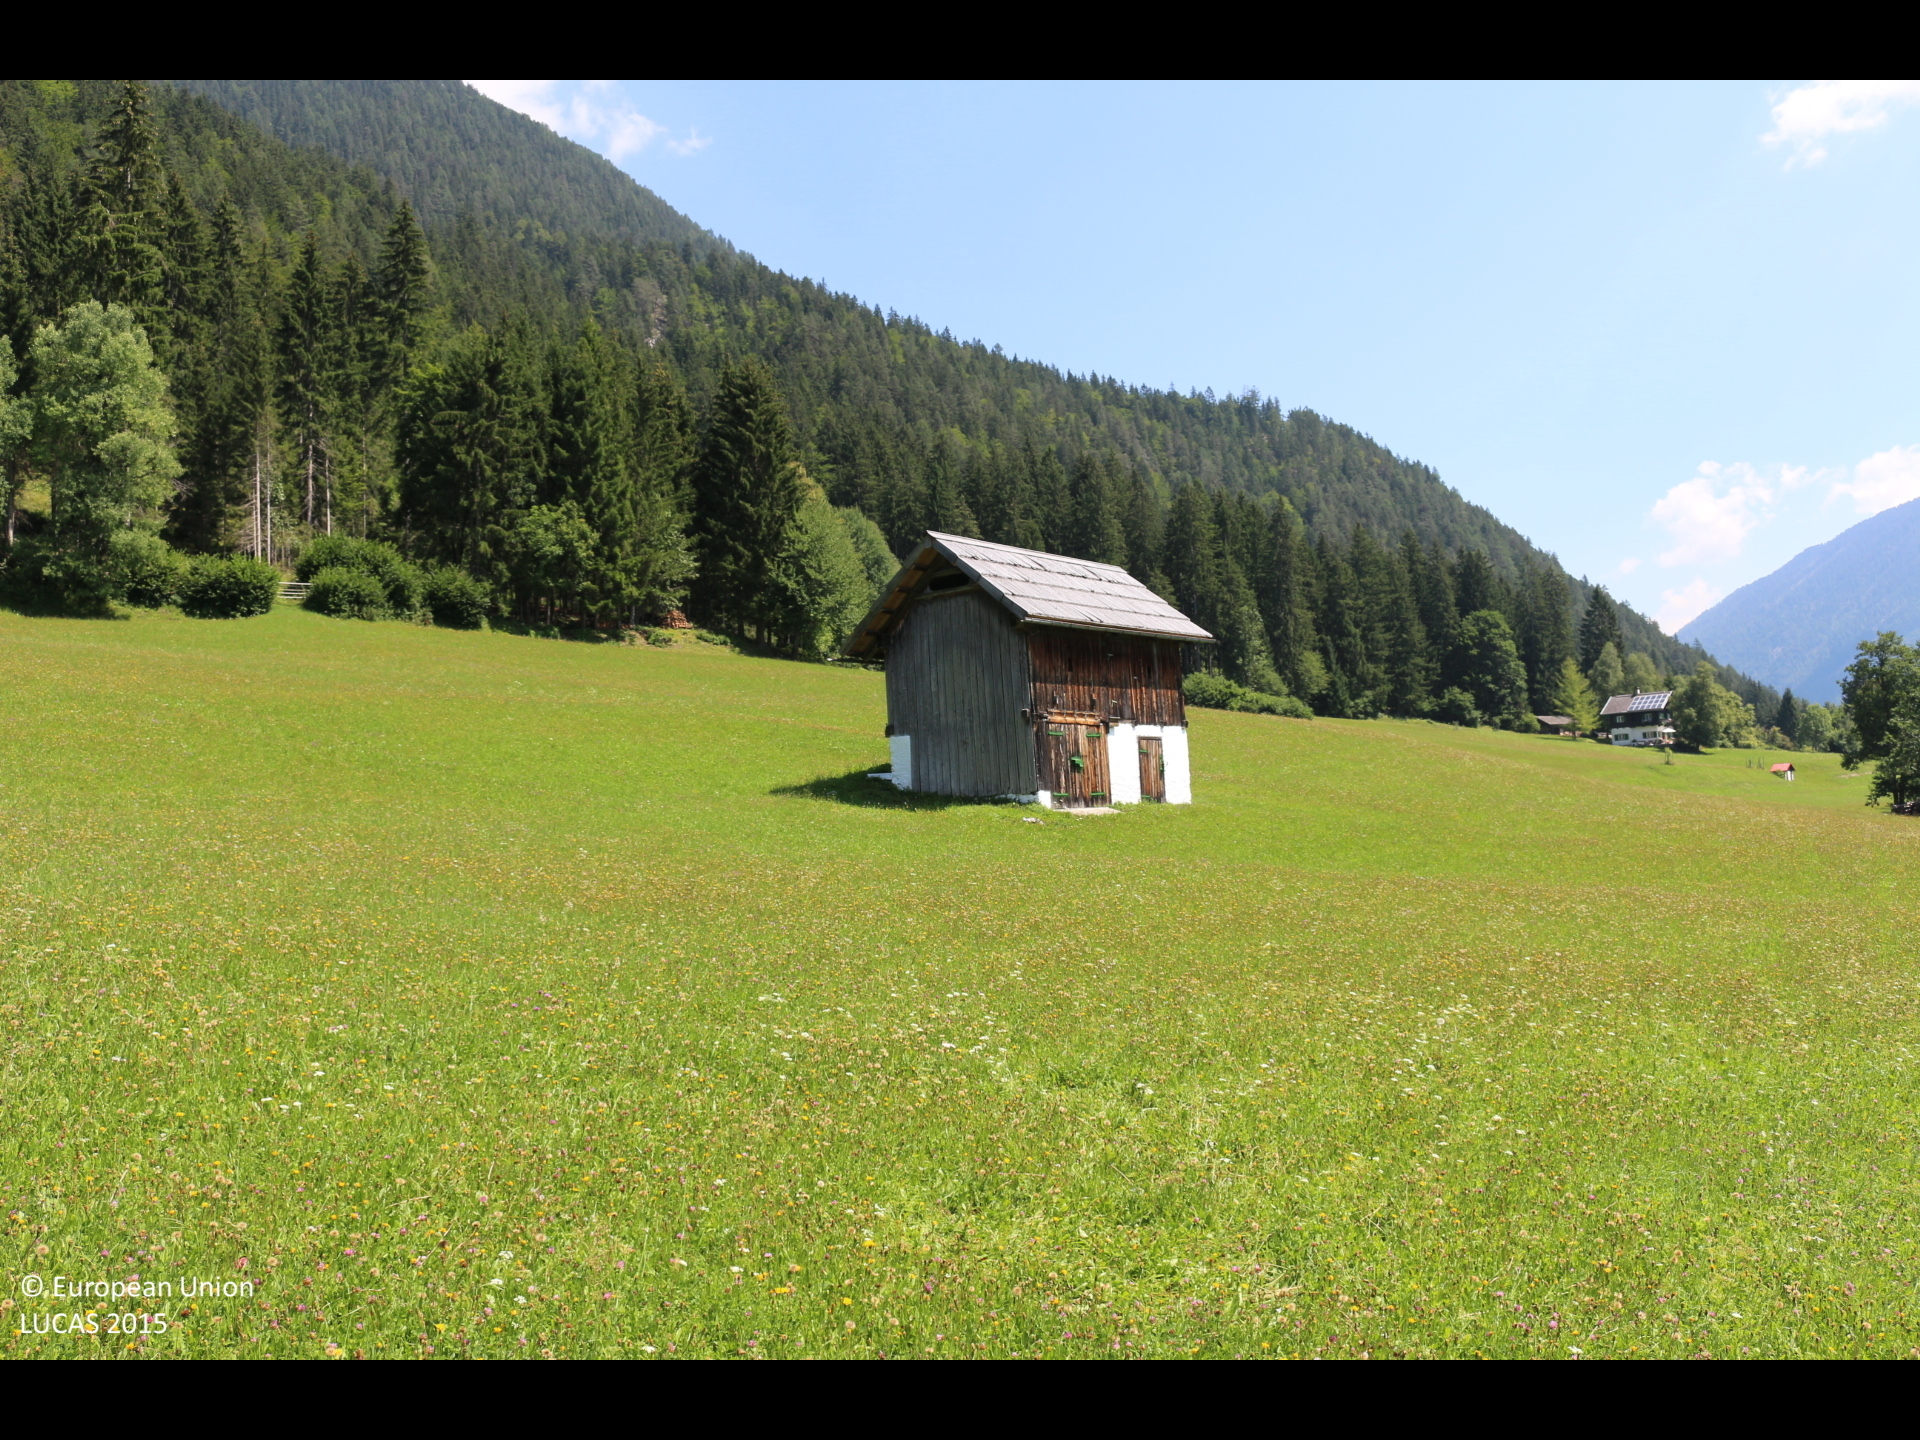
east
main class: Grassland
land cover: Grassland without tree/shrub cover
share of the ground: > 75 %
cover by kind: herbaceous plants 100 %
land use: Agriculture (excluding fallow land and kitchen gardens)
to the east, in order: Grassland without tree/shrub cover; Artificial constructions in urban areas; Grassland without tree/shrub cover; Other mixed woodland
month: August
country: AT
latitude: 46.7139
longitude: 13.3331
